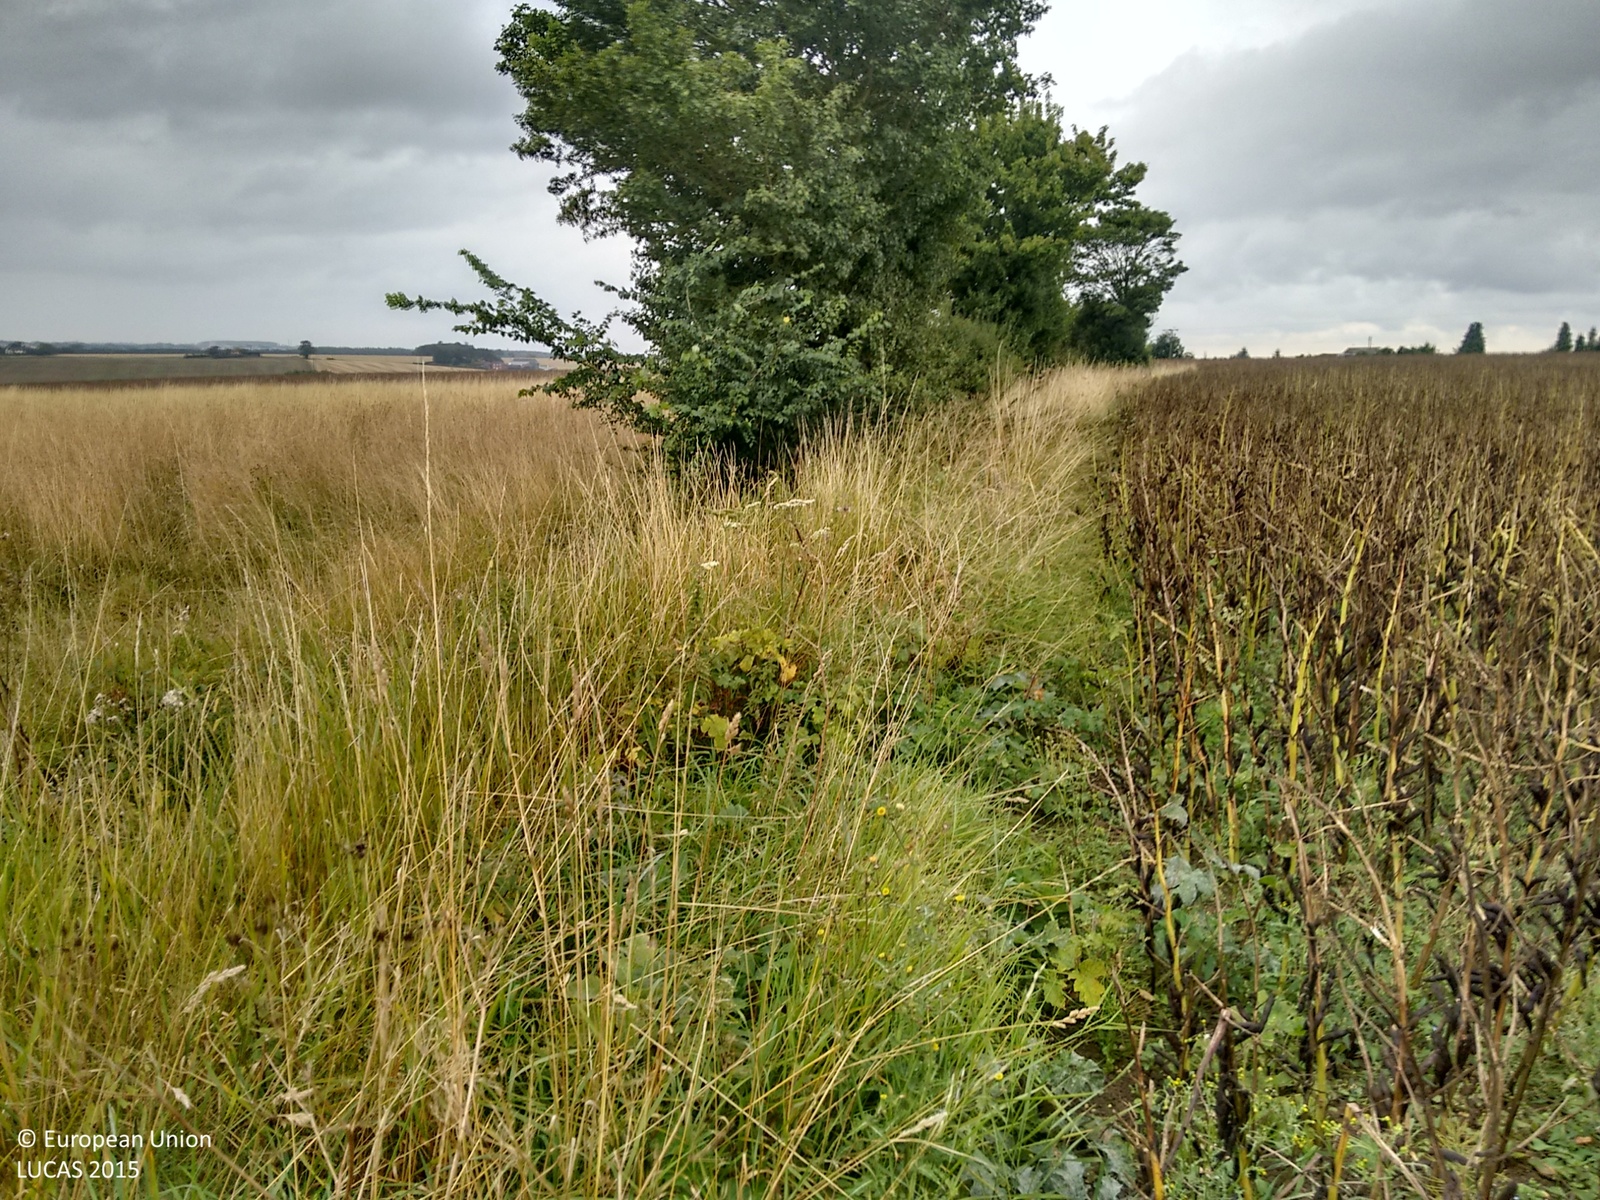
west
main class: Cropland
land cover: Dry pulses
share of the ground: > 75 %
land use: Agriculture (excluding fallow land and kitchen gardens)
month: August
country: GB
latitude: 52.0863
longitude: 0.5008
